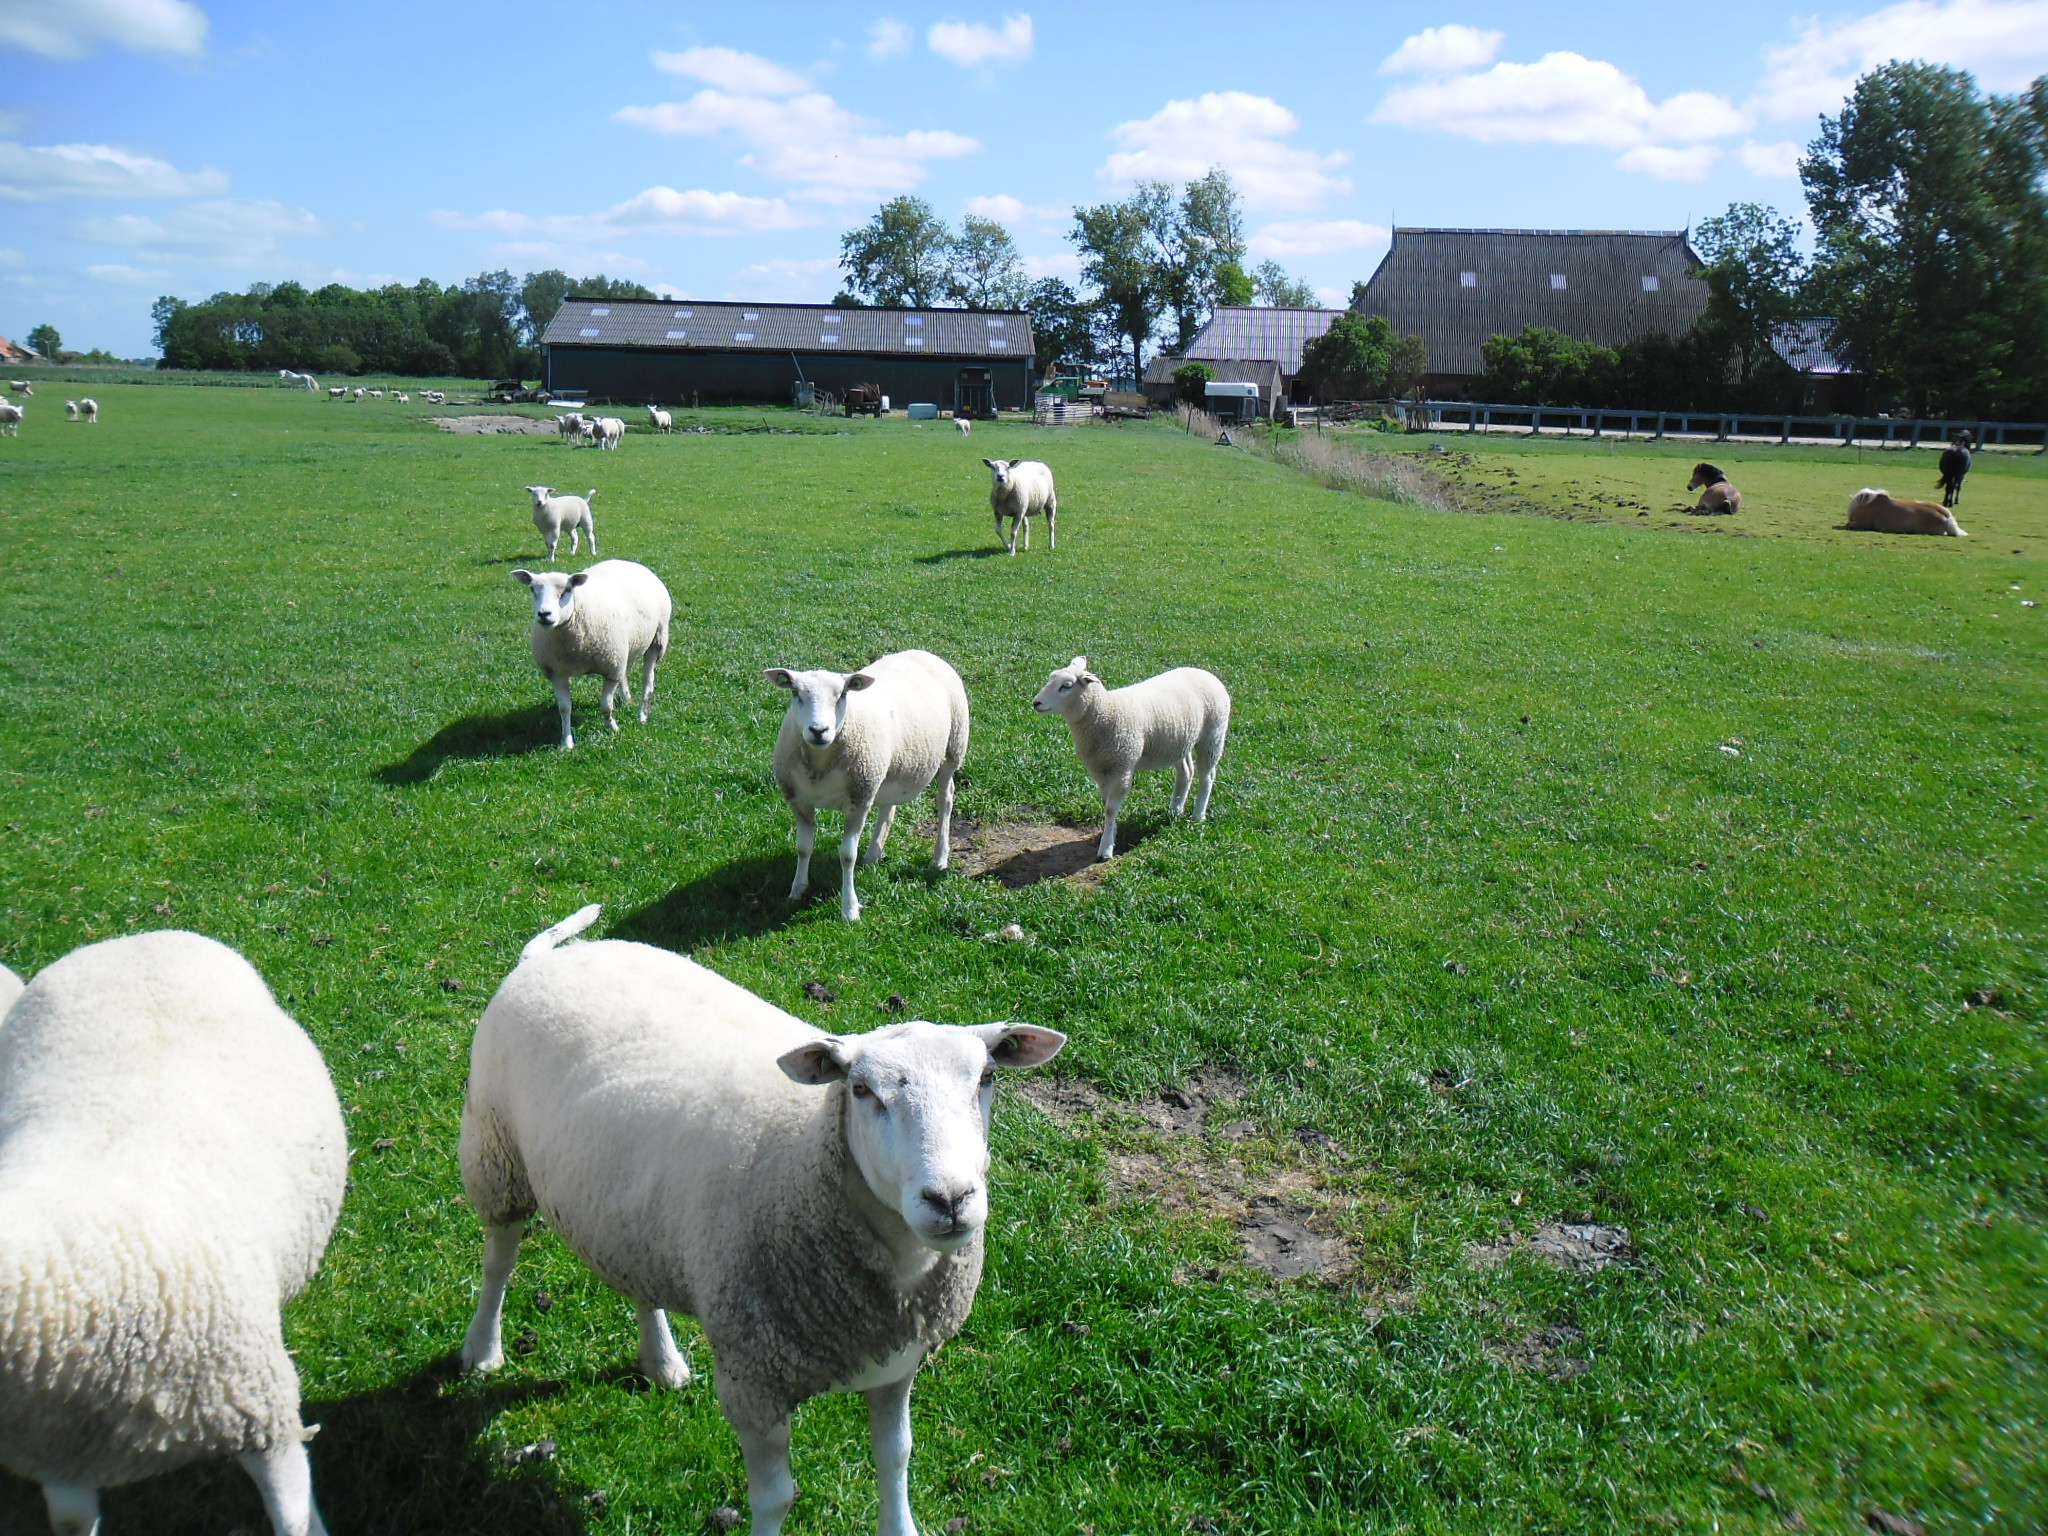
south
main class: Grassland
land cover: Grassland without tree/shrub cover
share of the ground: > 75 %
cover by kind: herbaceous plants 100 %
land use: Agriculture (excluding fallow land and kitchen gardens)
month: June
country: NL
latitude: 53.2123
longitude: 5.5515
